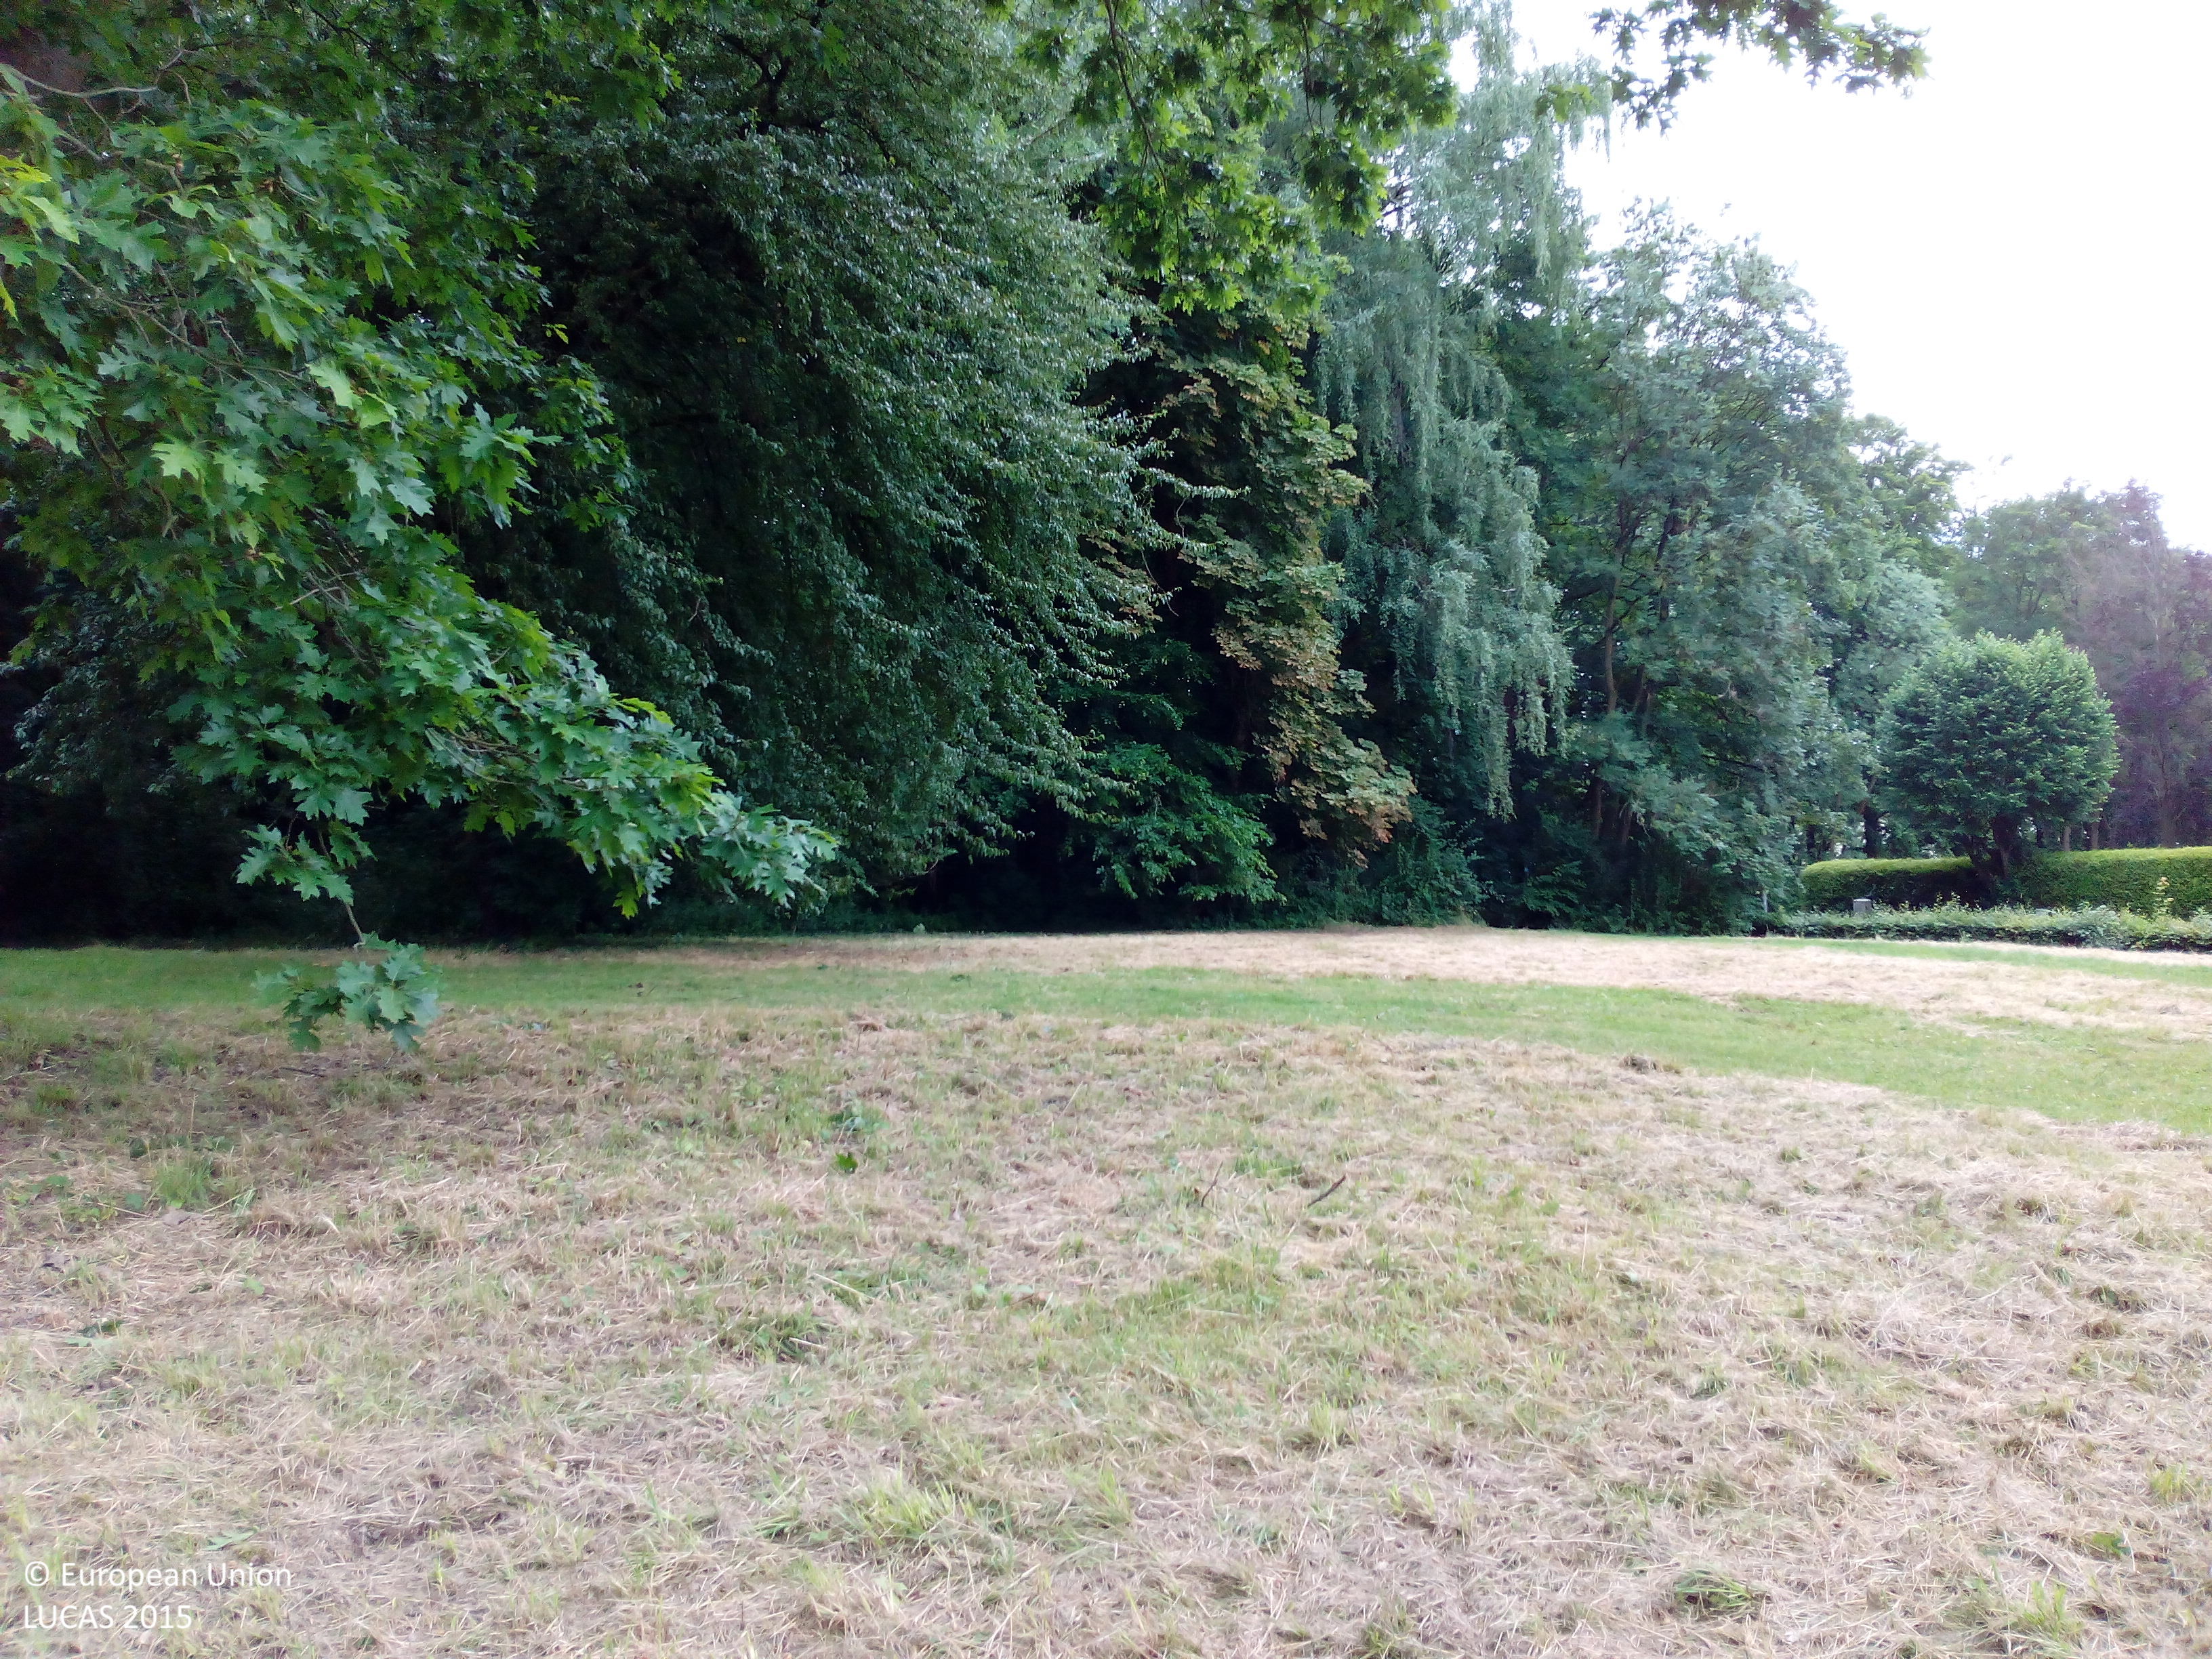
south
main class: Grassland
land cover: Grassland without tree/shrub cover
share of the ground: > 75 %
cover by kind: herbaceous plants 100 %
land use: Community services
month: July
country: DE
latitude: 51.5326
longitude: 9.9568
